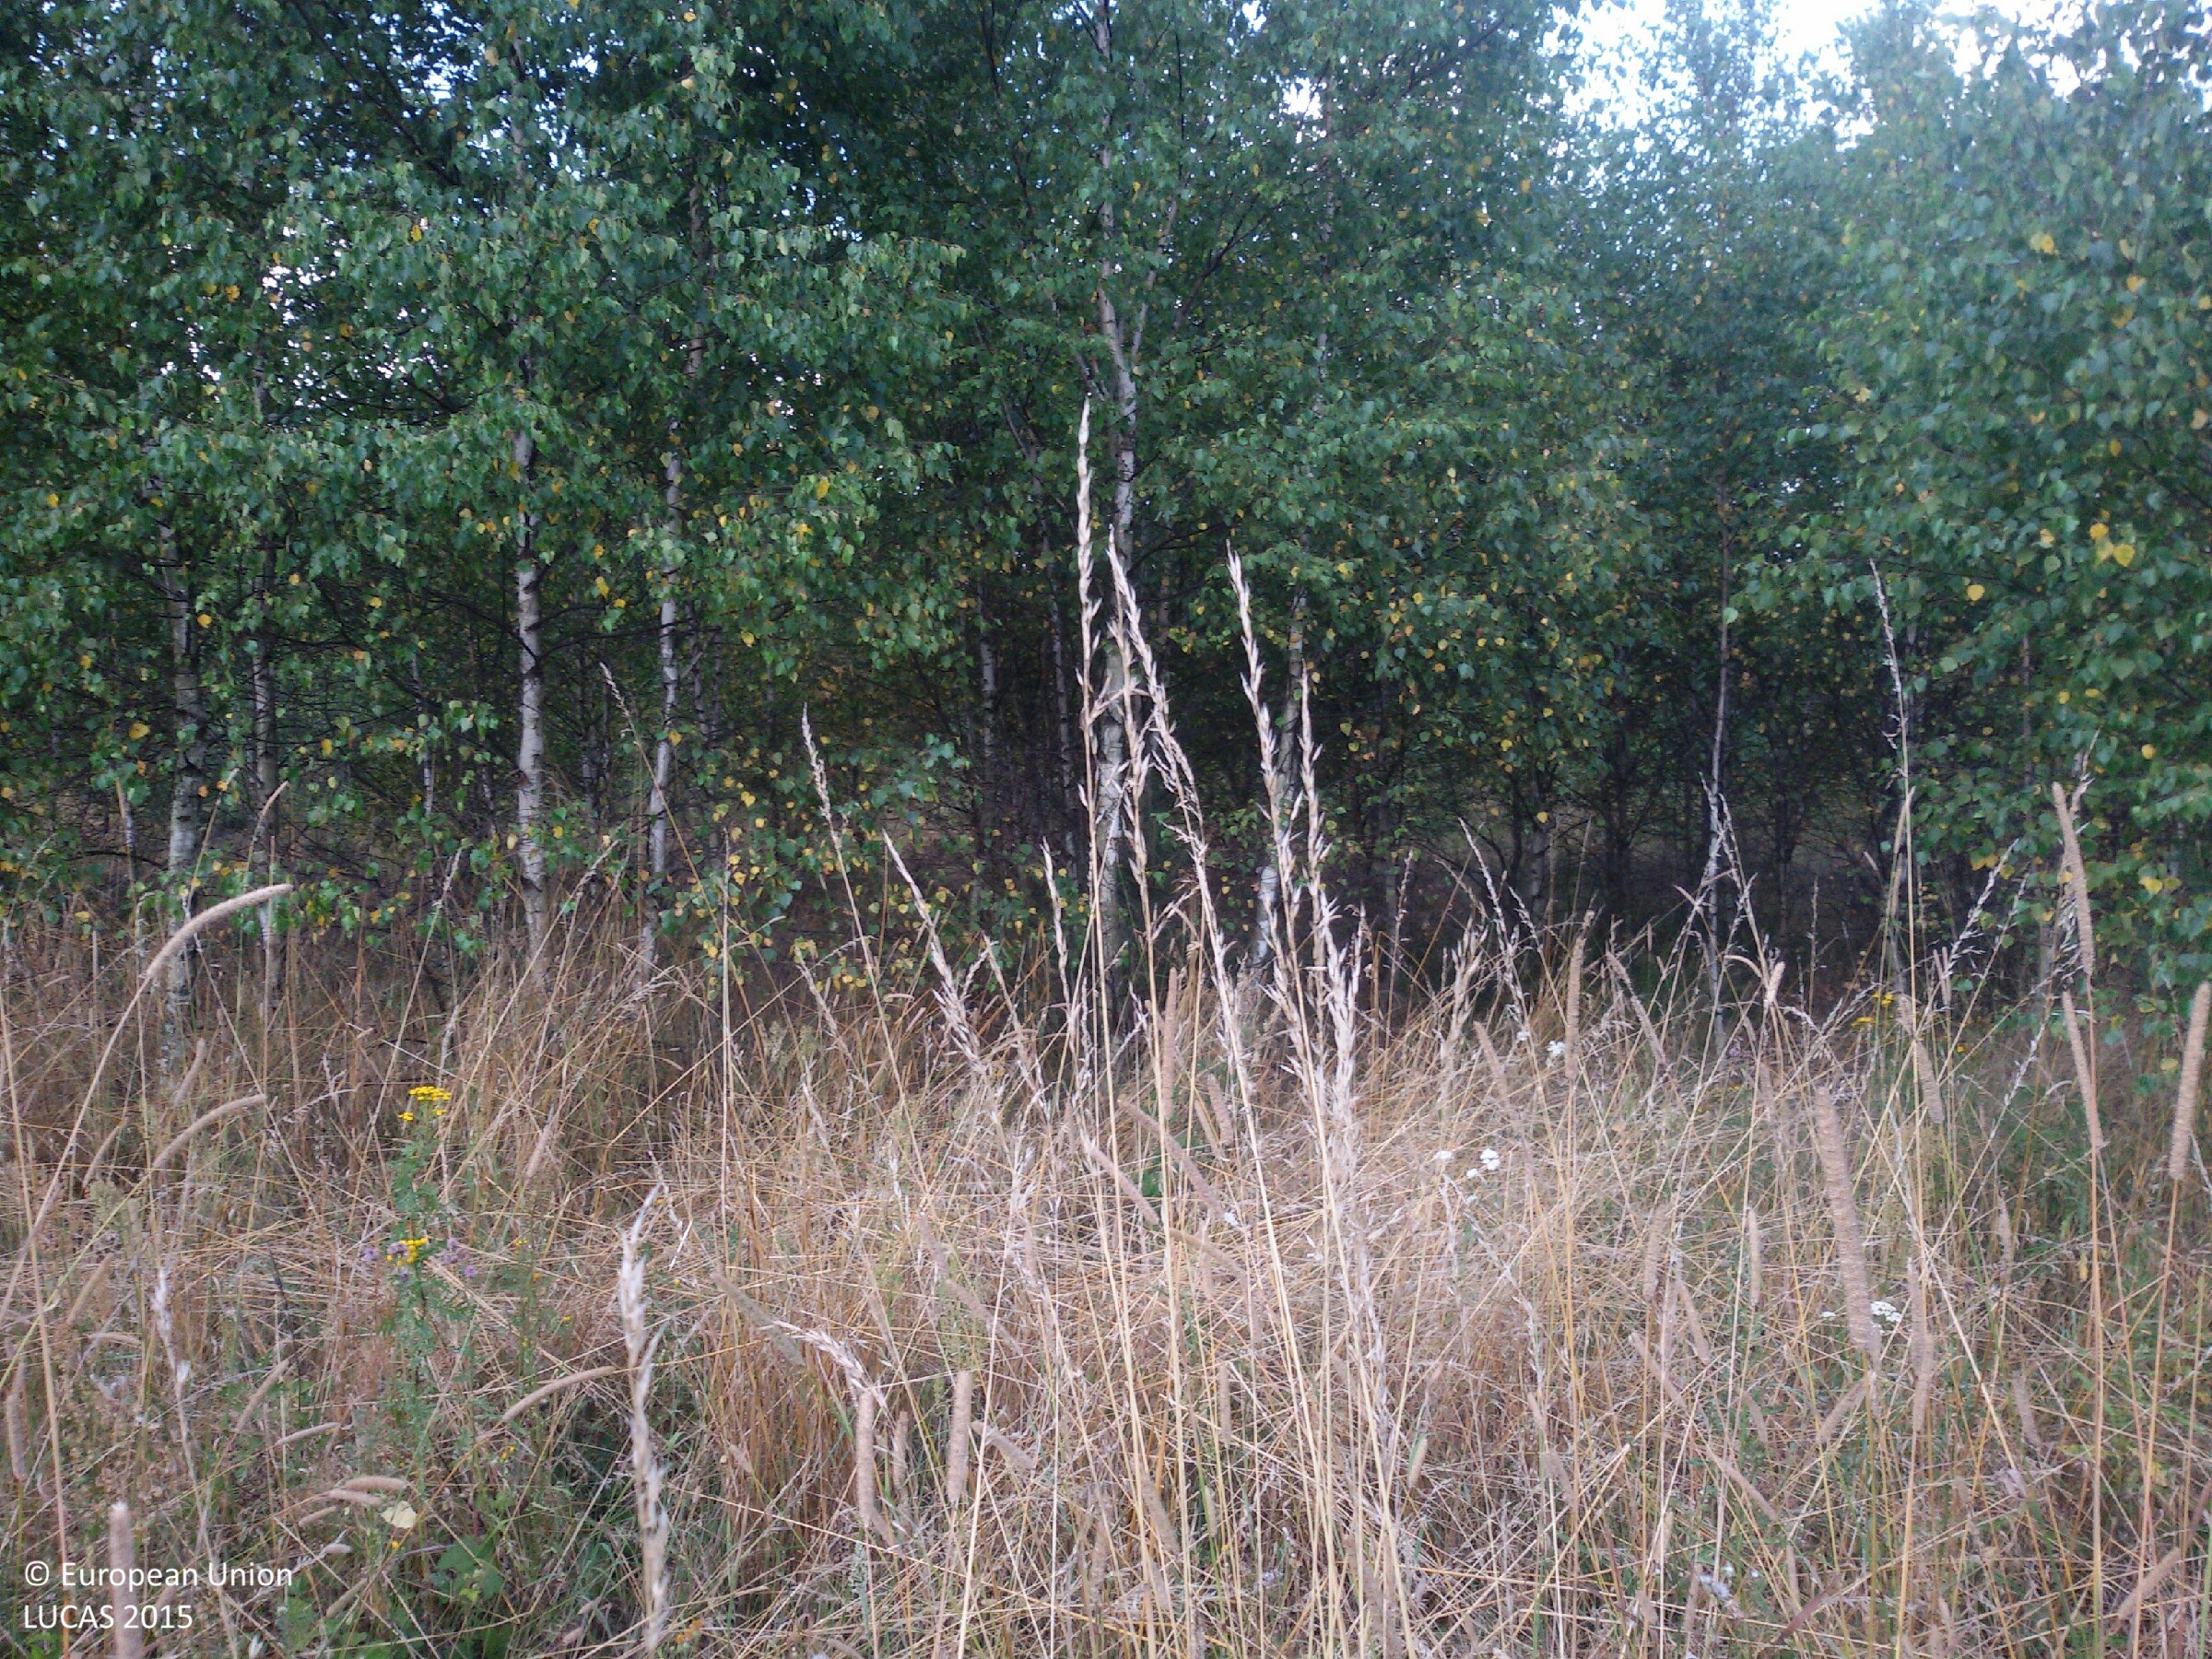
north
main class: Grassland
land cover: Grassland with sparse tree/shrub cover
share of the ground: > 75 %
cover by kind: herbaceous plants 95 %, coniferous forest trees 5 %
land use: Abandoned areas
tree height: < 5 m
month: August
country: PL
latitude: 51.2019
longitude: 20.9061
